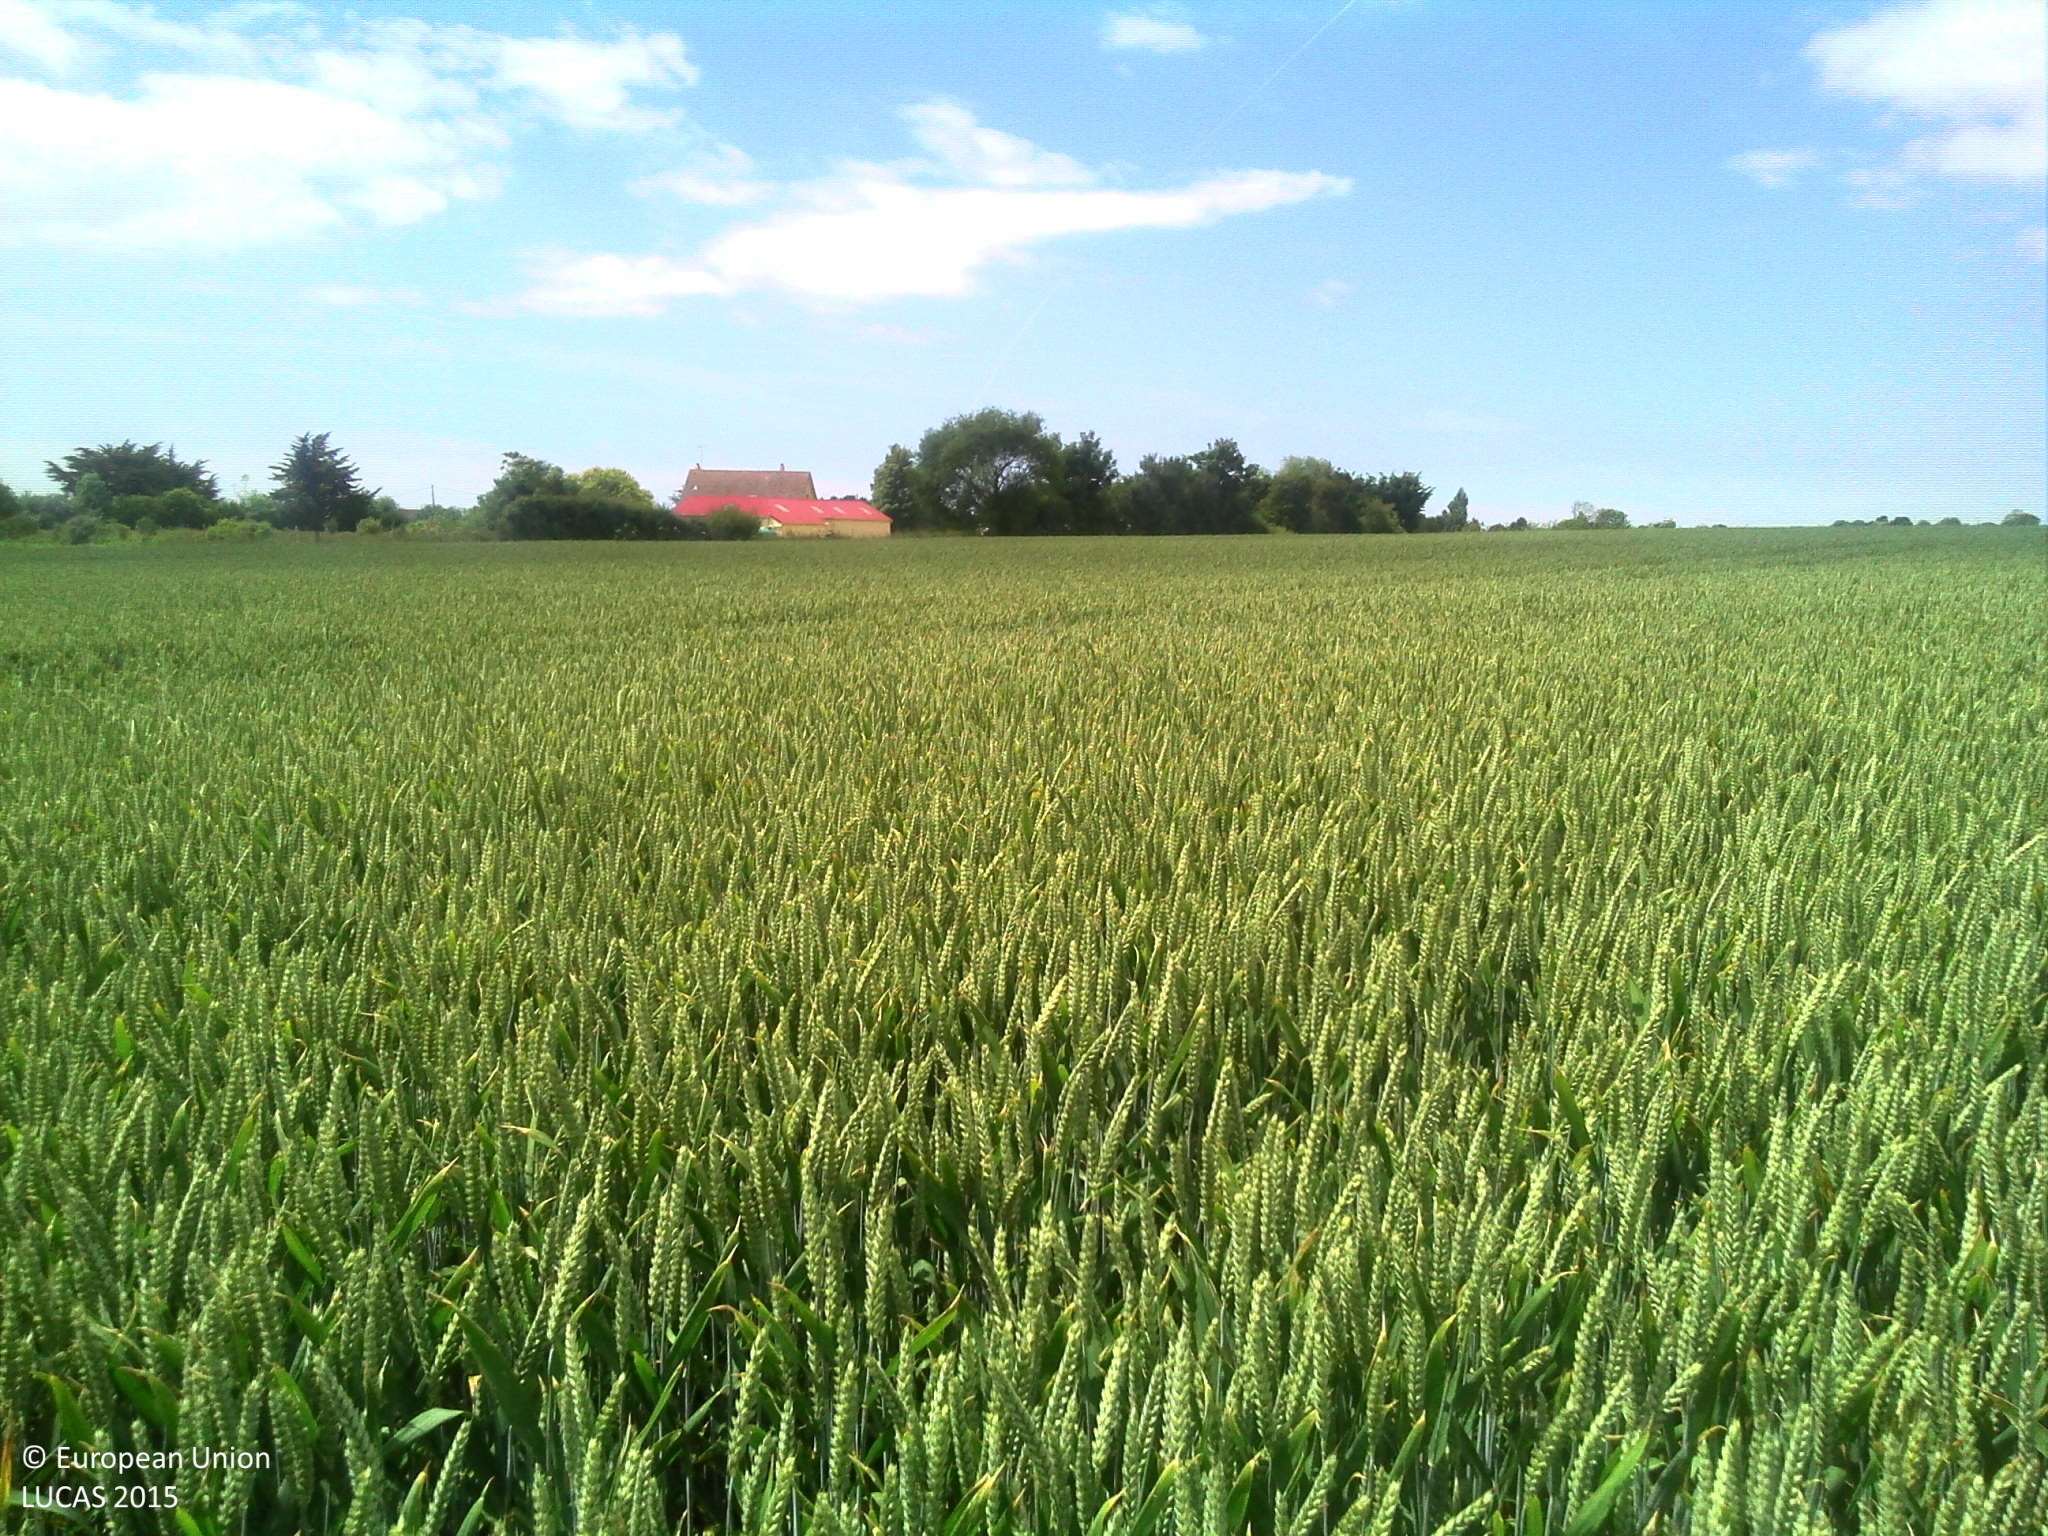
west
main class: Cropland
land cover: Common wheat
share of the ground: > 75 %
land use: Agriculture (excluding fallow land and kitchen gardens)
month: June
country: FR
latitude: 49.3450
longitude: -1.6826
